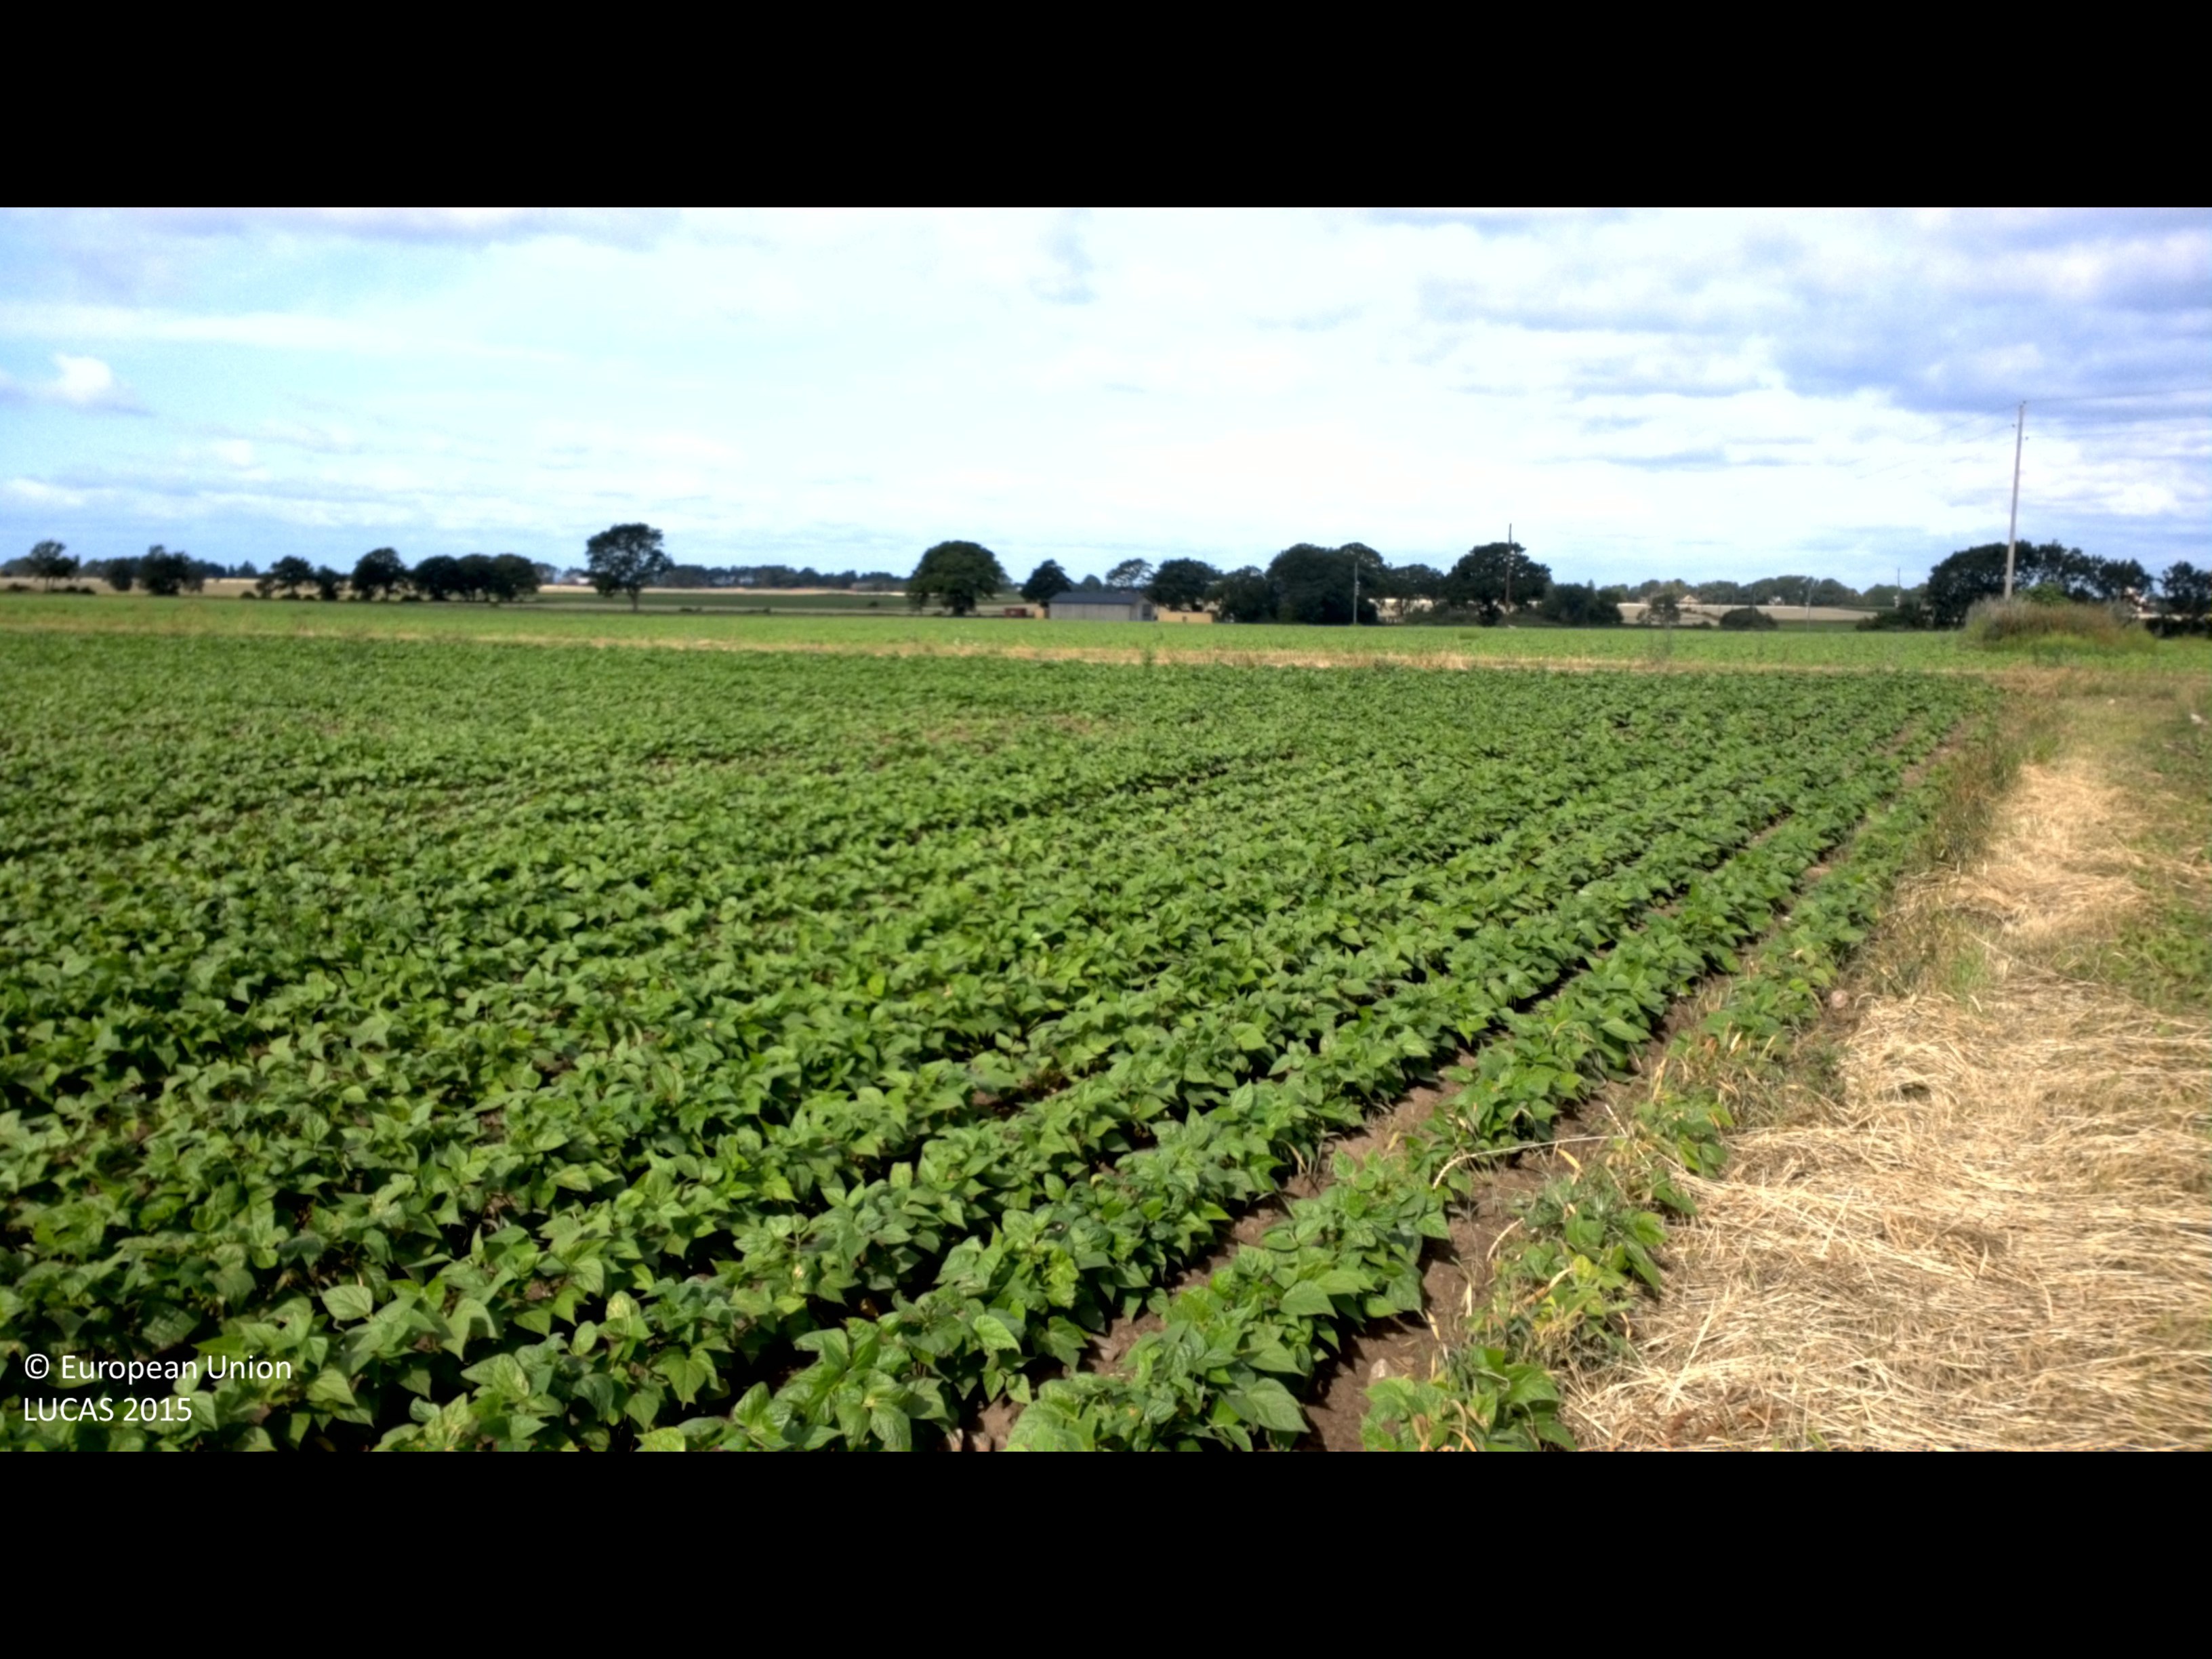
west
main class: Cropland
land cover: Dry pulses
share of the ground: > 75 %
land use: Agriculture (excluding fallow land and kitchen gardens)
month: July
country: SE
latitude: 56.5141
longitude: 16.4208
